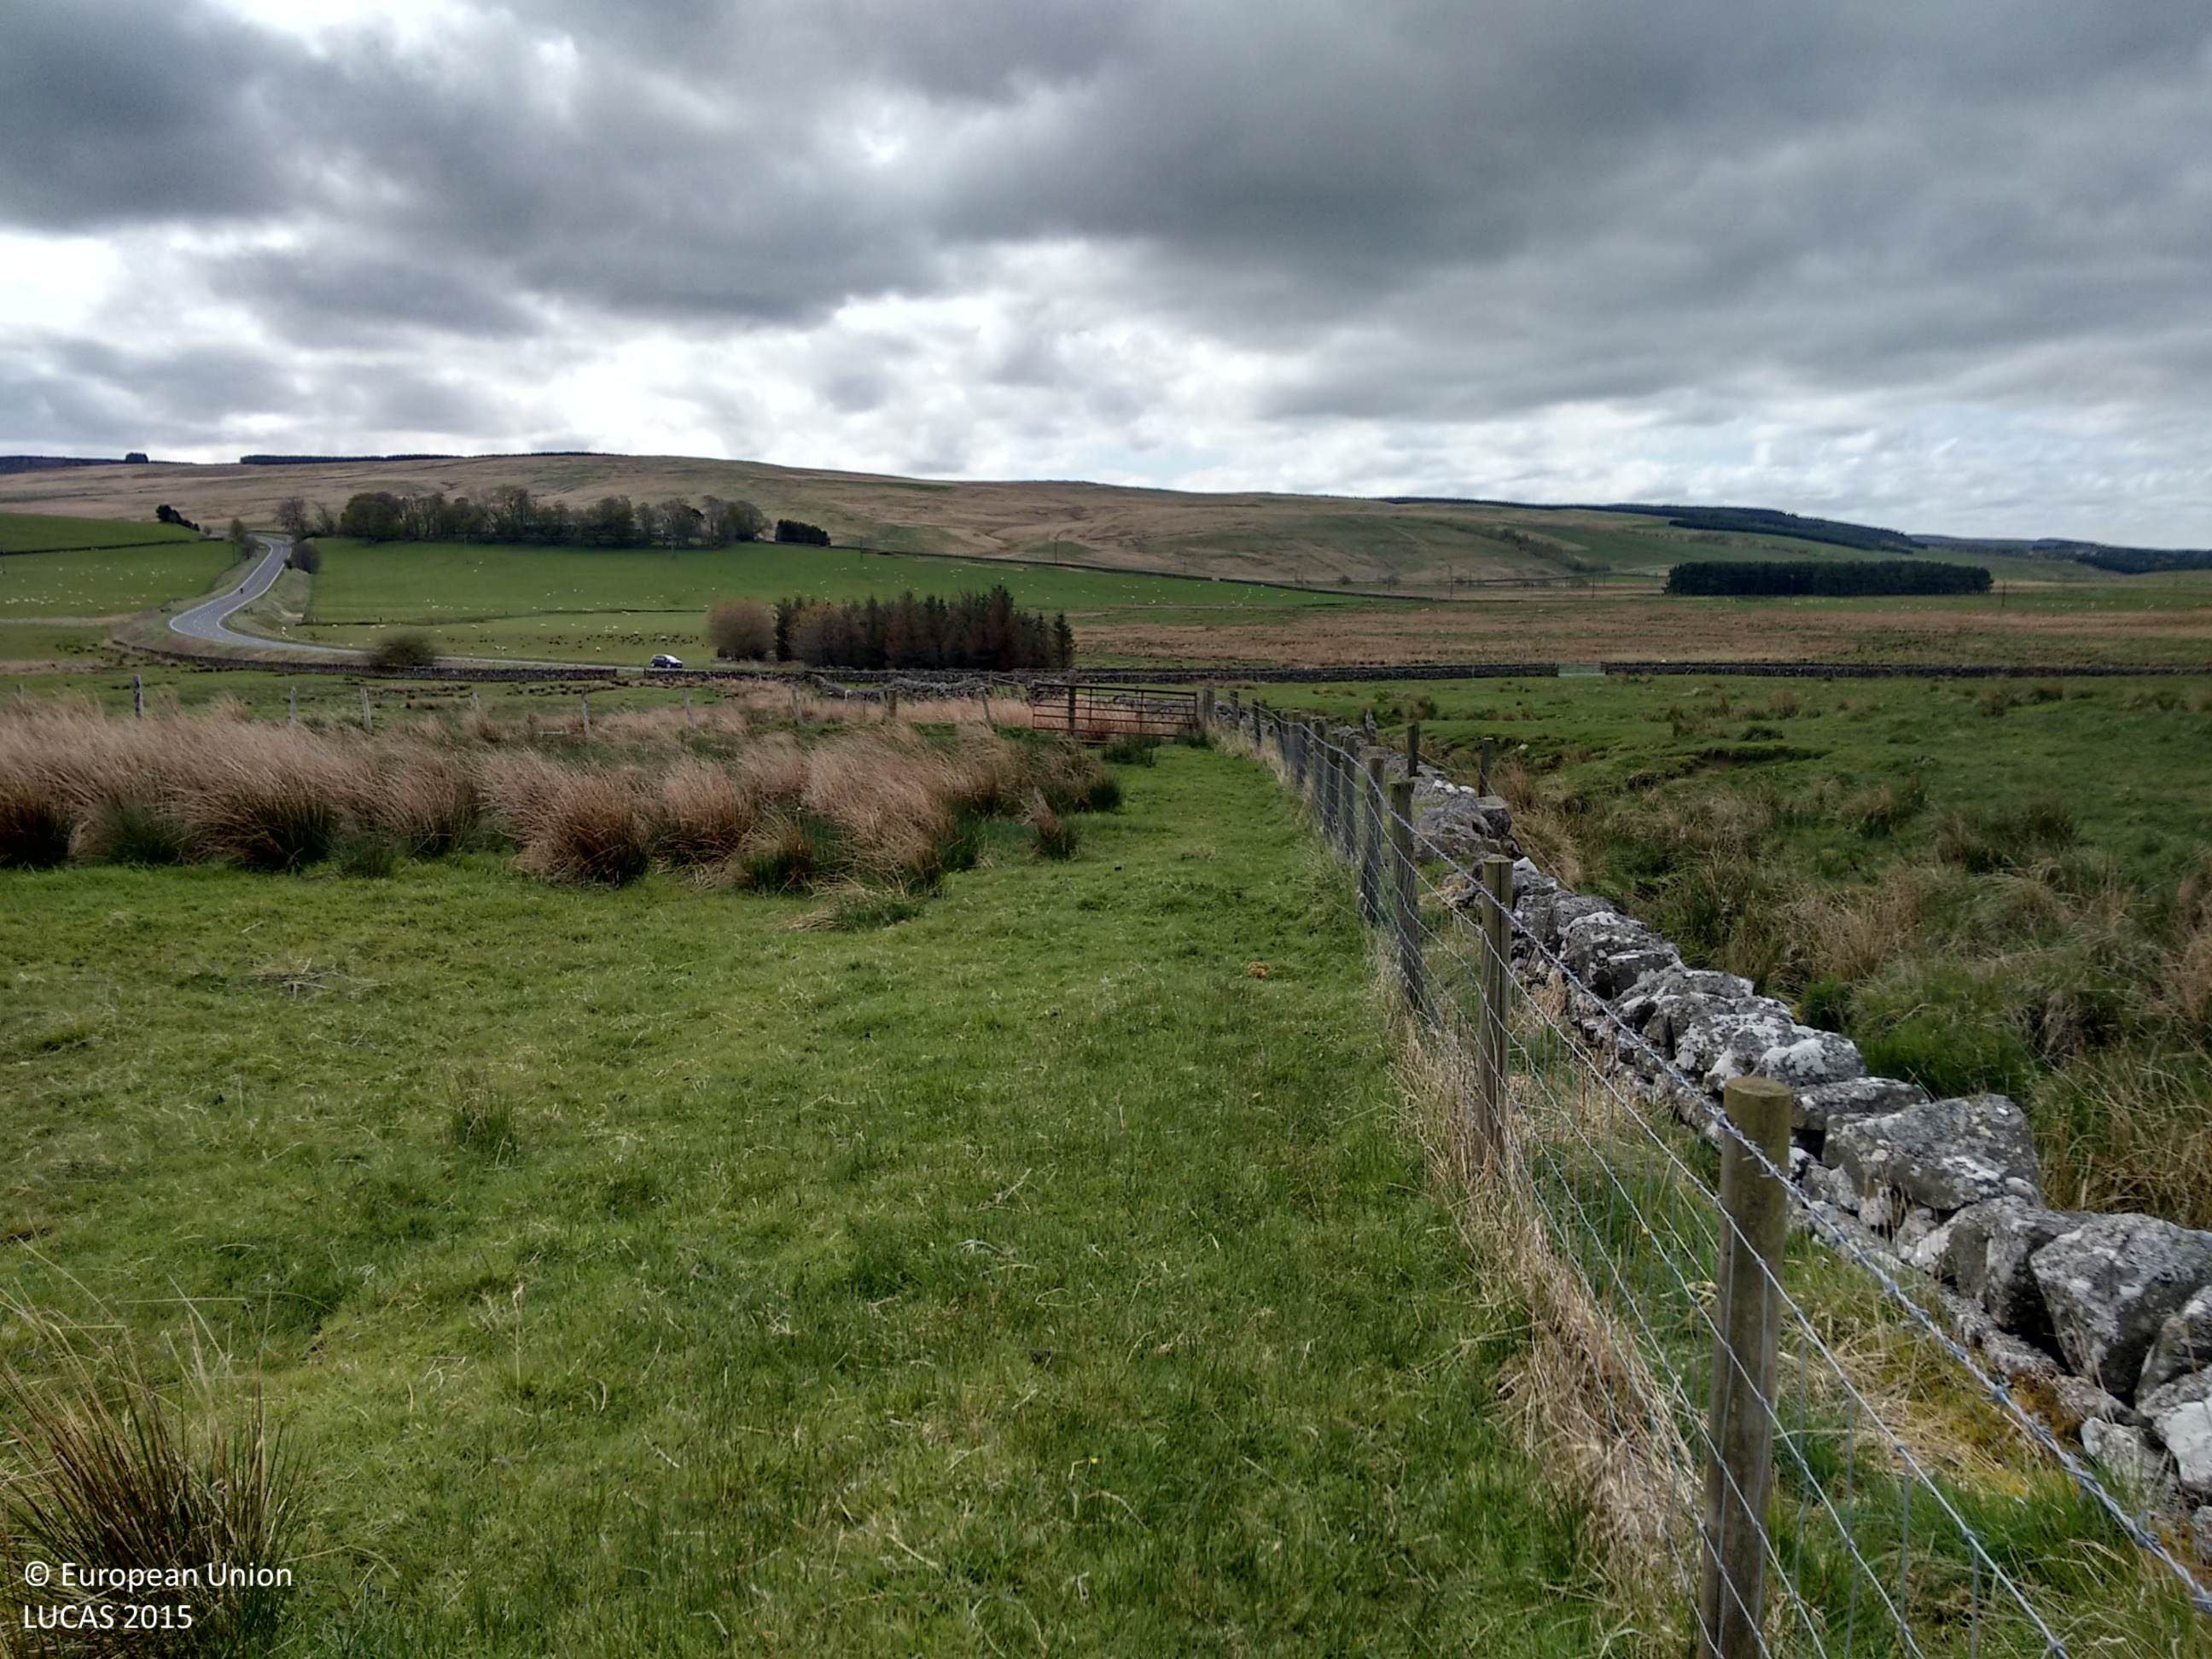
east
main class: Grassland
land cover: Grassland without tree/shrub cover
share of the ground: > 75 %
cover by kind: herbaceous plants 100 %
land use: Agriculture (excluding fallow land and kitchen gardens)
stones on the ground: < 10 %
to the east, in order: Grassland without tree/shrub cover; Rivers and streams; Dry stone walls; Fences; Grassland without tree/shrub cover; Fences; Grassland without tree/shrub cover
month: May
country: GB
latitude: 55.2259
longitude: -2.1460
